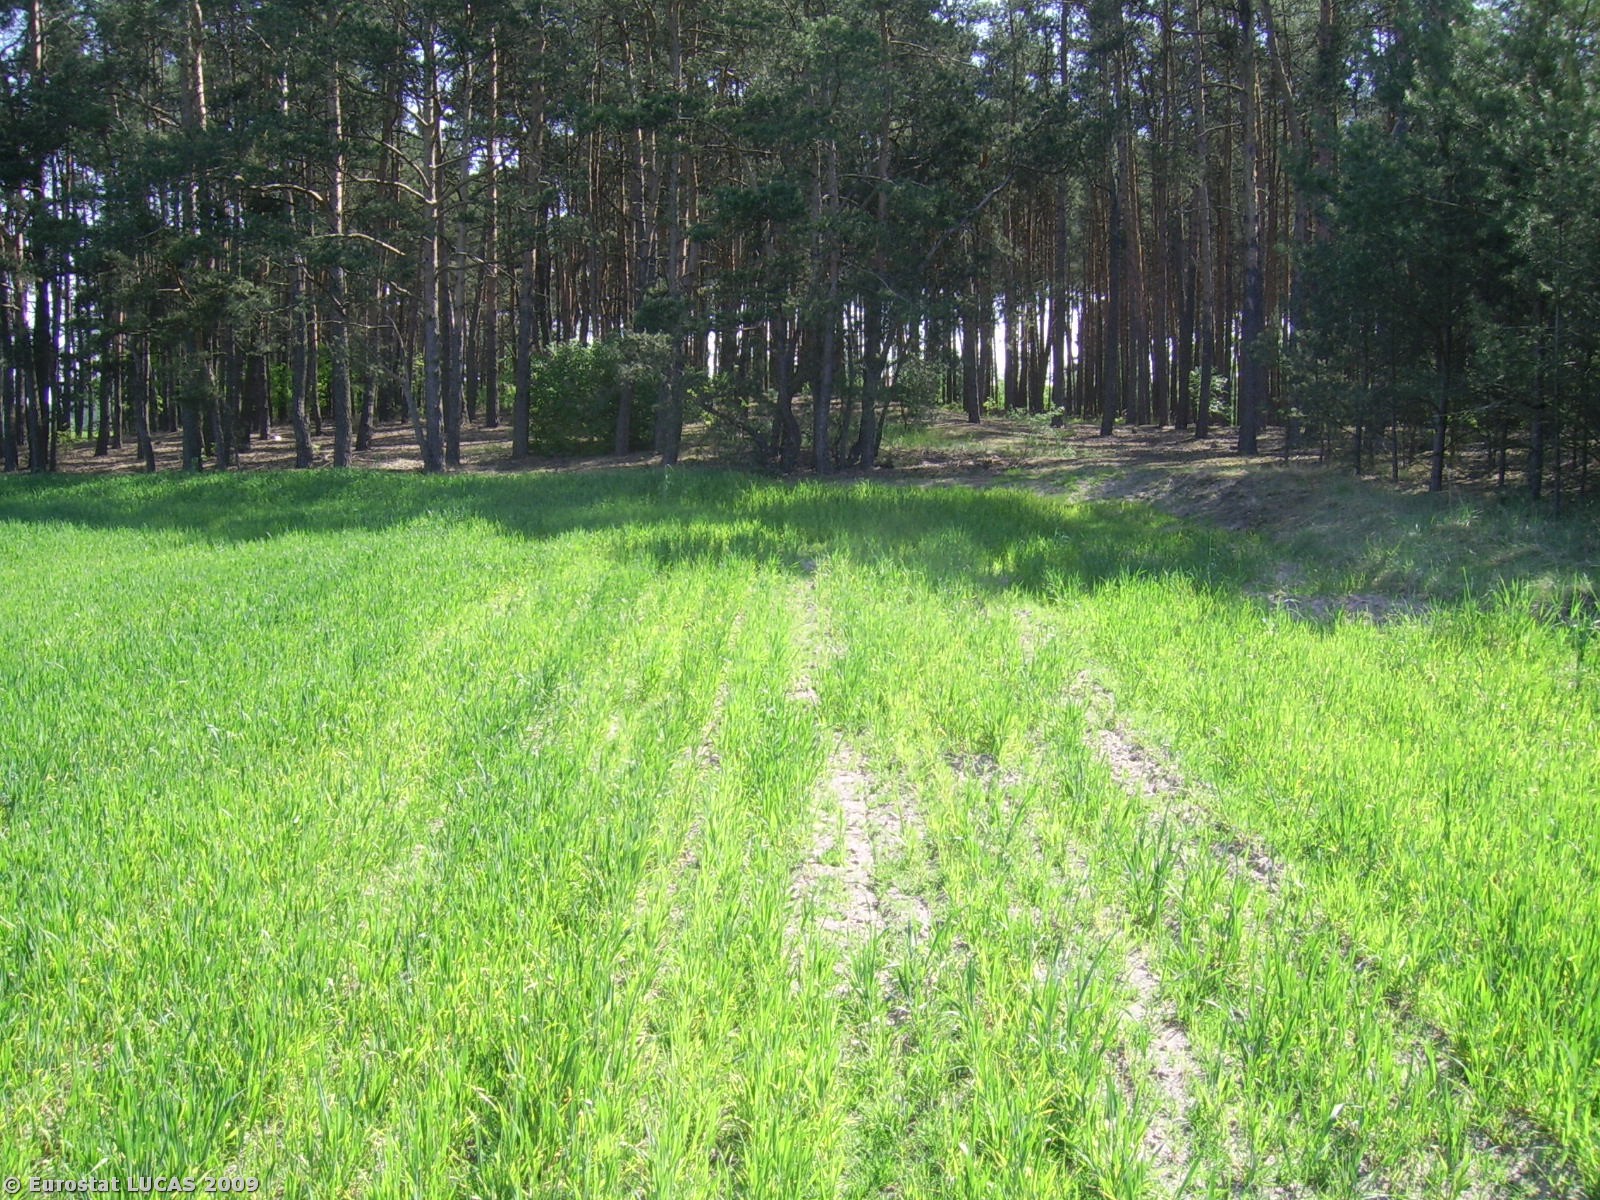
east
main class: Cropland
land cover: Common wheat
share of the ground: > 75 %
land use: Agriculture (excluding fallow land and kitchen gardens)
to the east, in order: Common wheat; Mixed woodland; Fences; Artificial constructions in urban areas
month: April
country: PL
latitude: 52.2109
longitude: 16.9318
